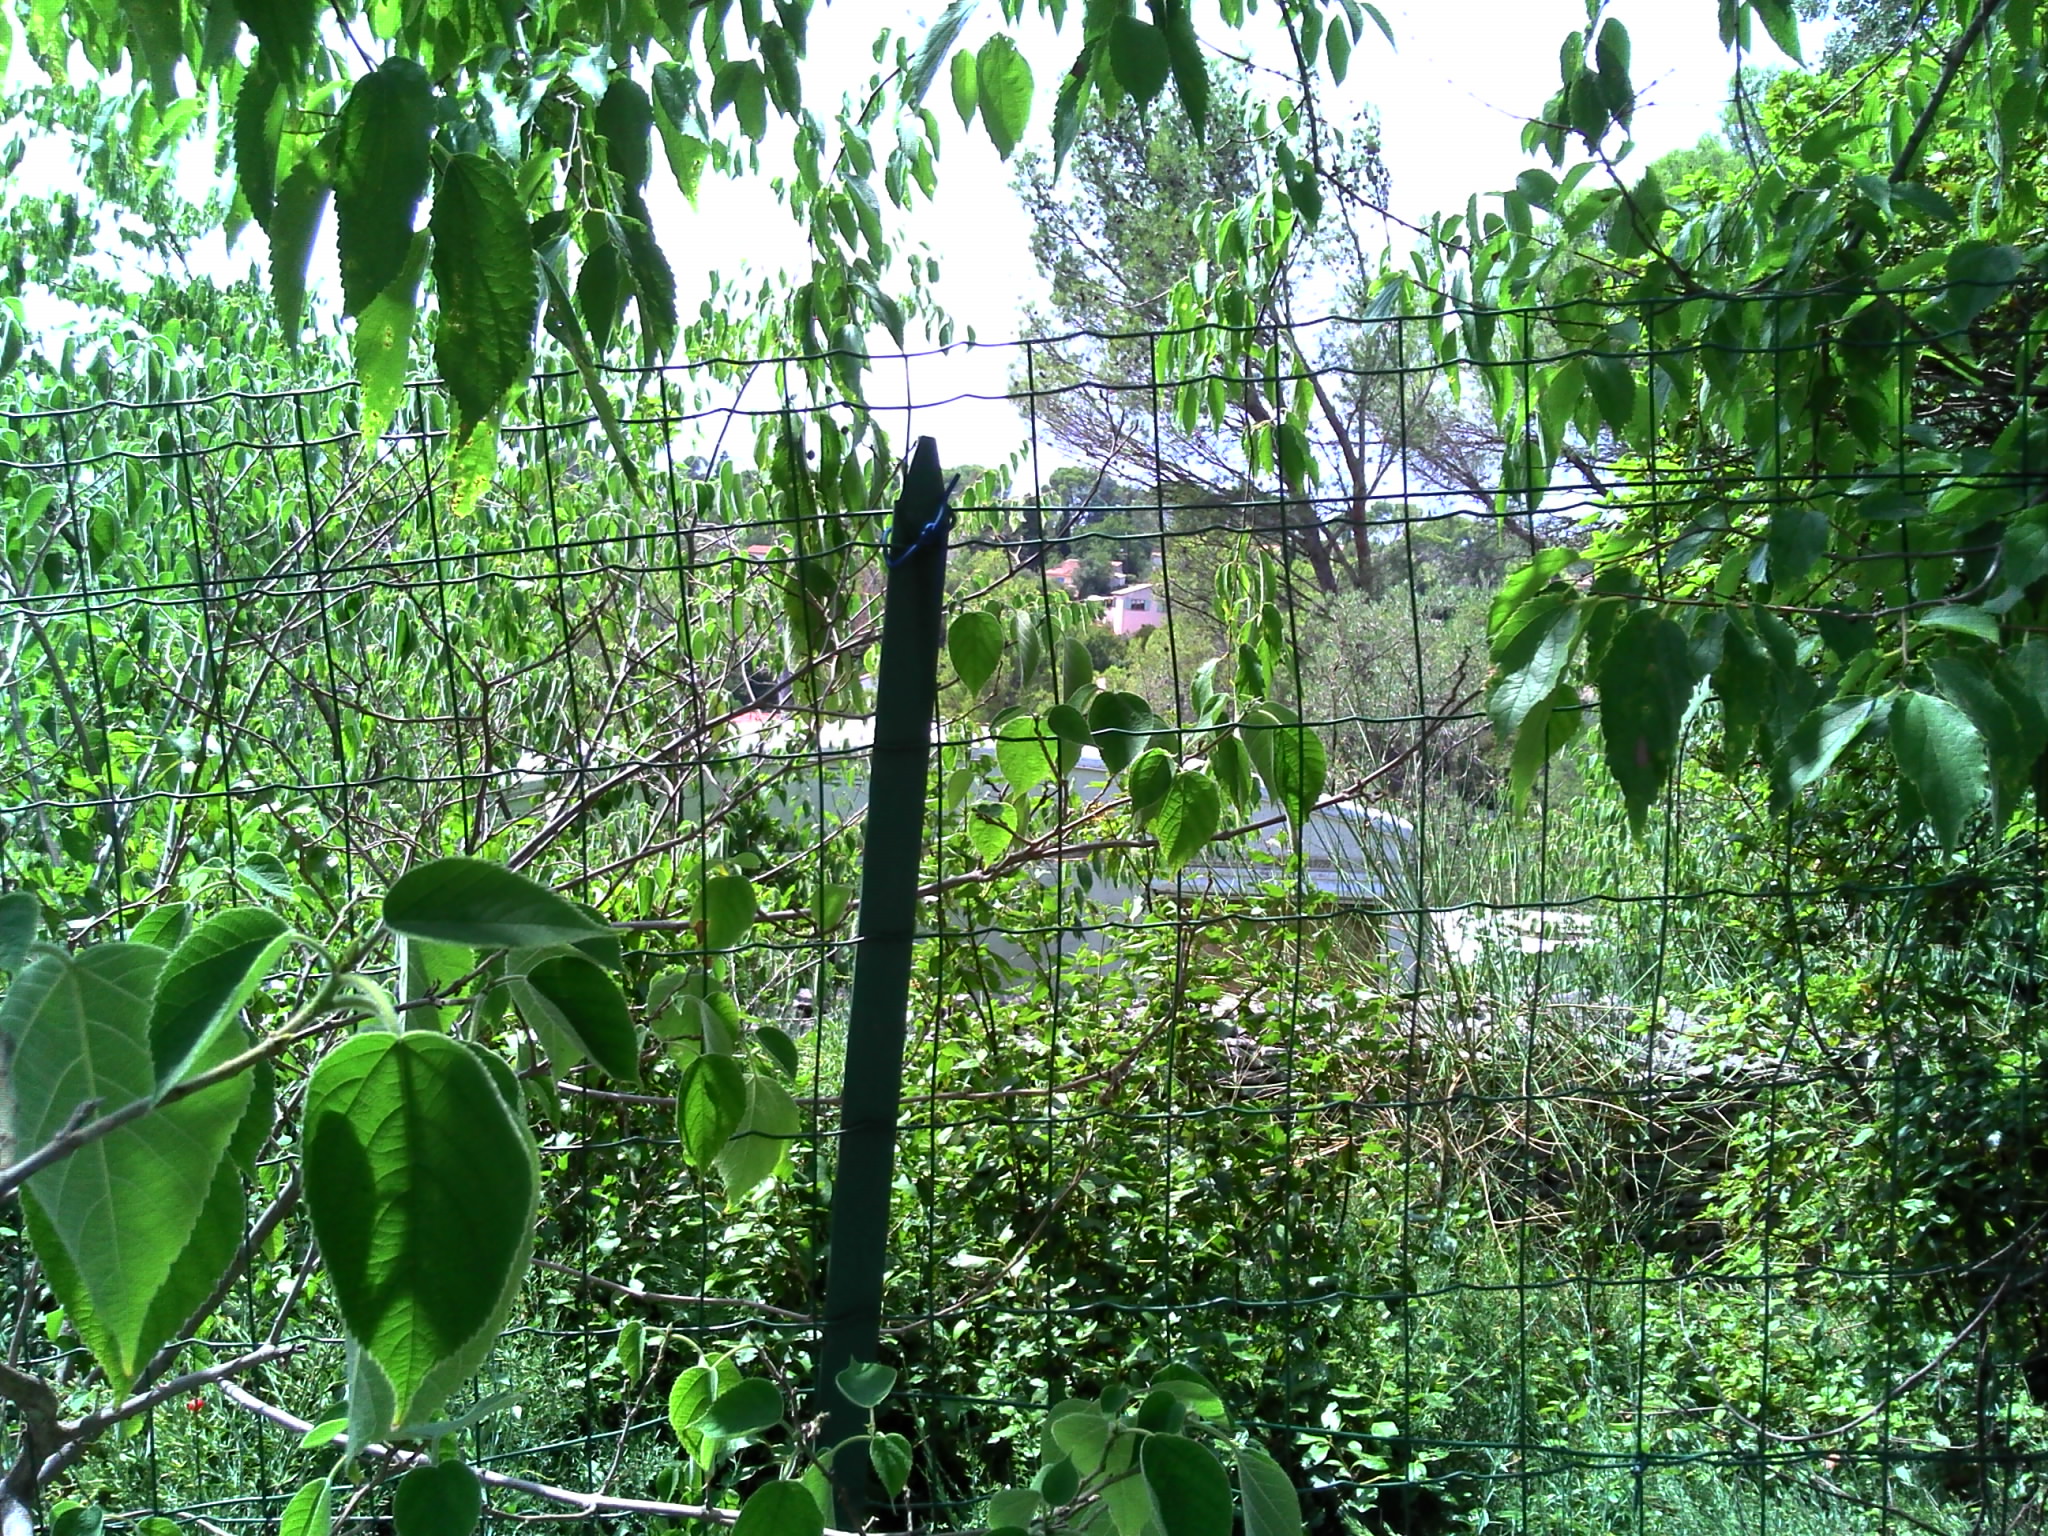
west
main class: Woodland
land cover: Pine dominated mixed woodland
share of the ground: 50 - 75 %
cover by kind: coniferous forest trees 30 %, broadleaved forest trees 30 %, herbaceous plants 20 %, consolidated bare surface 20 %
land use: Residential
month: August
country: FR
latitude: 43.8544
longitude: 4.3732
